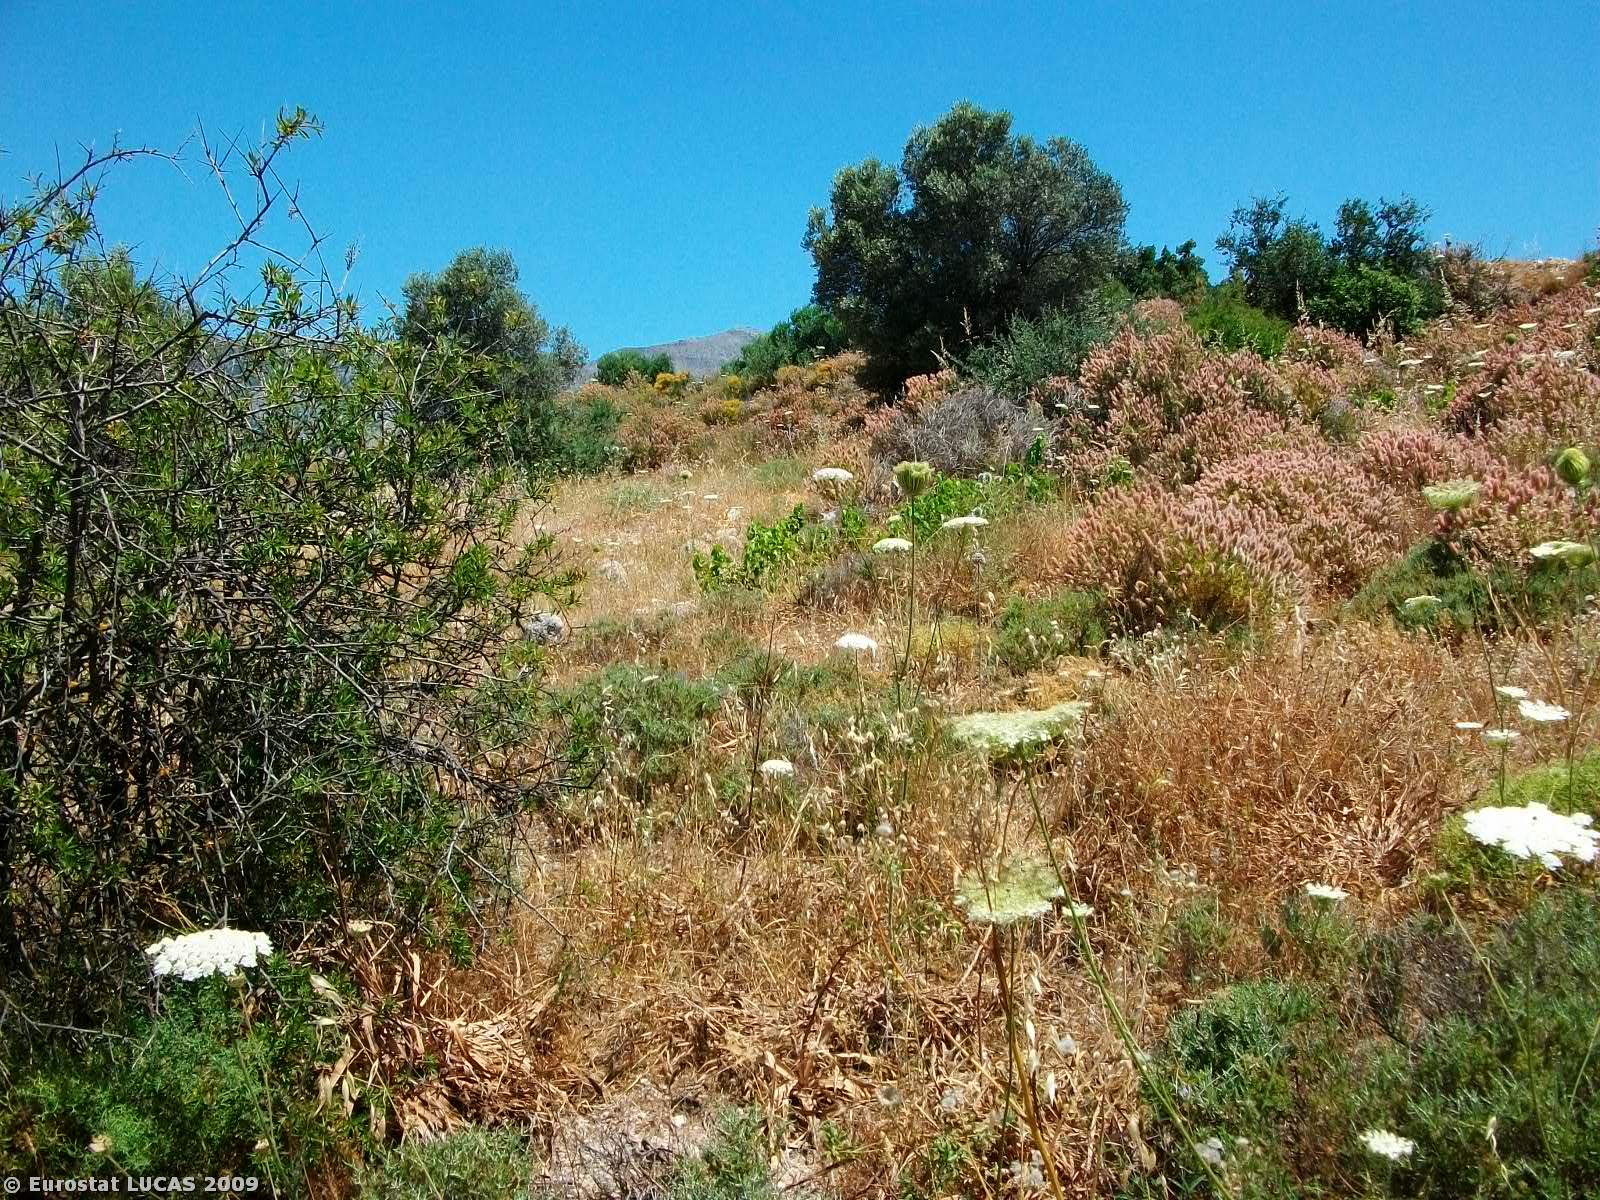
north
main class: Shrubland
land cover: Shrubland with sparse tree cover
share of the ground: > 75 %
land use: Unused
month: June
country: GR
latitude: 35.1047
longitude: 24.9397
